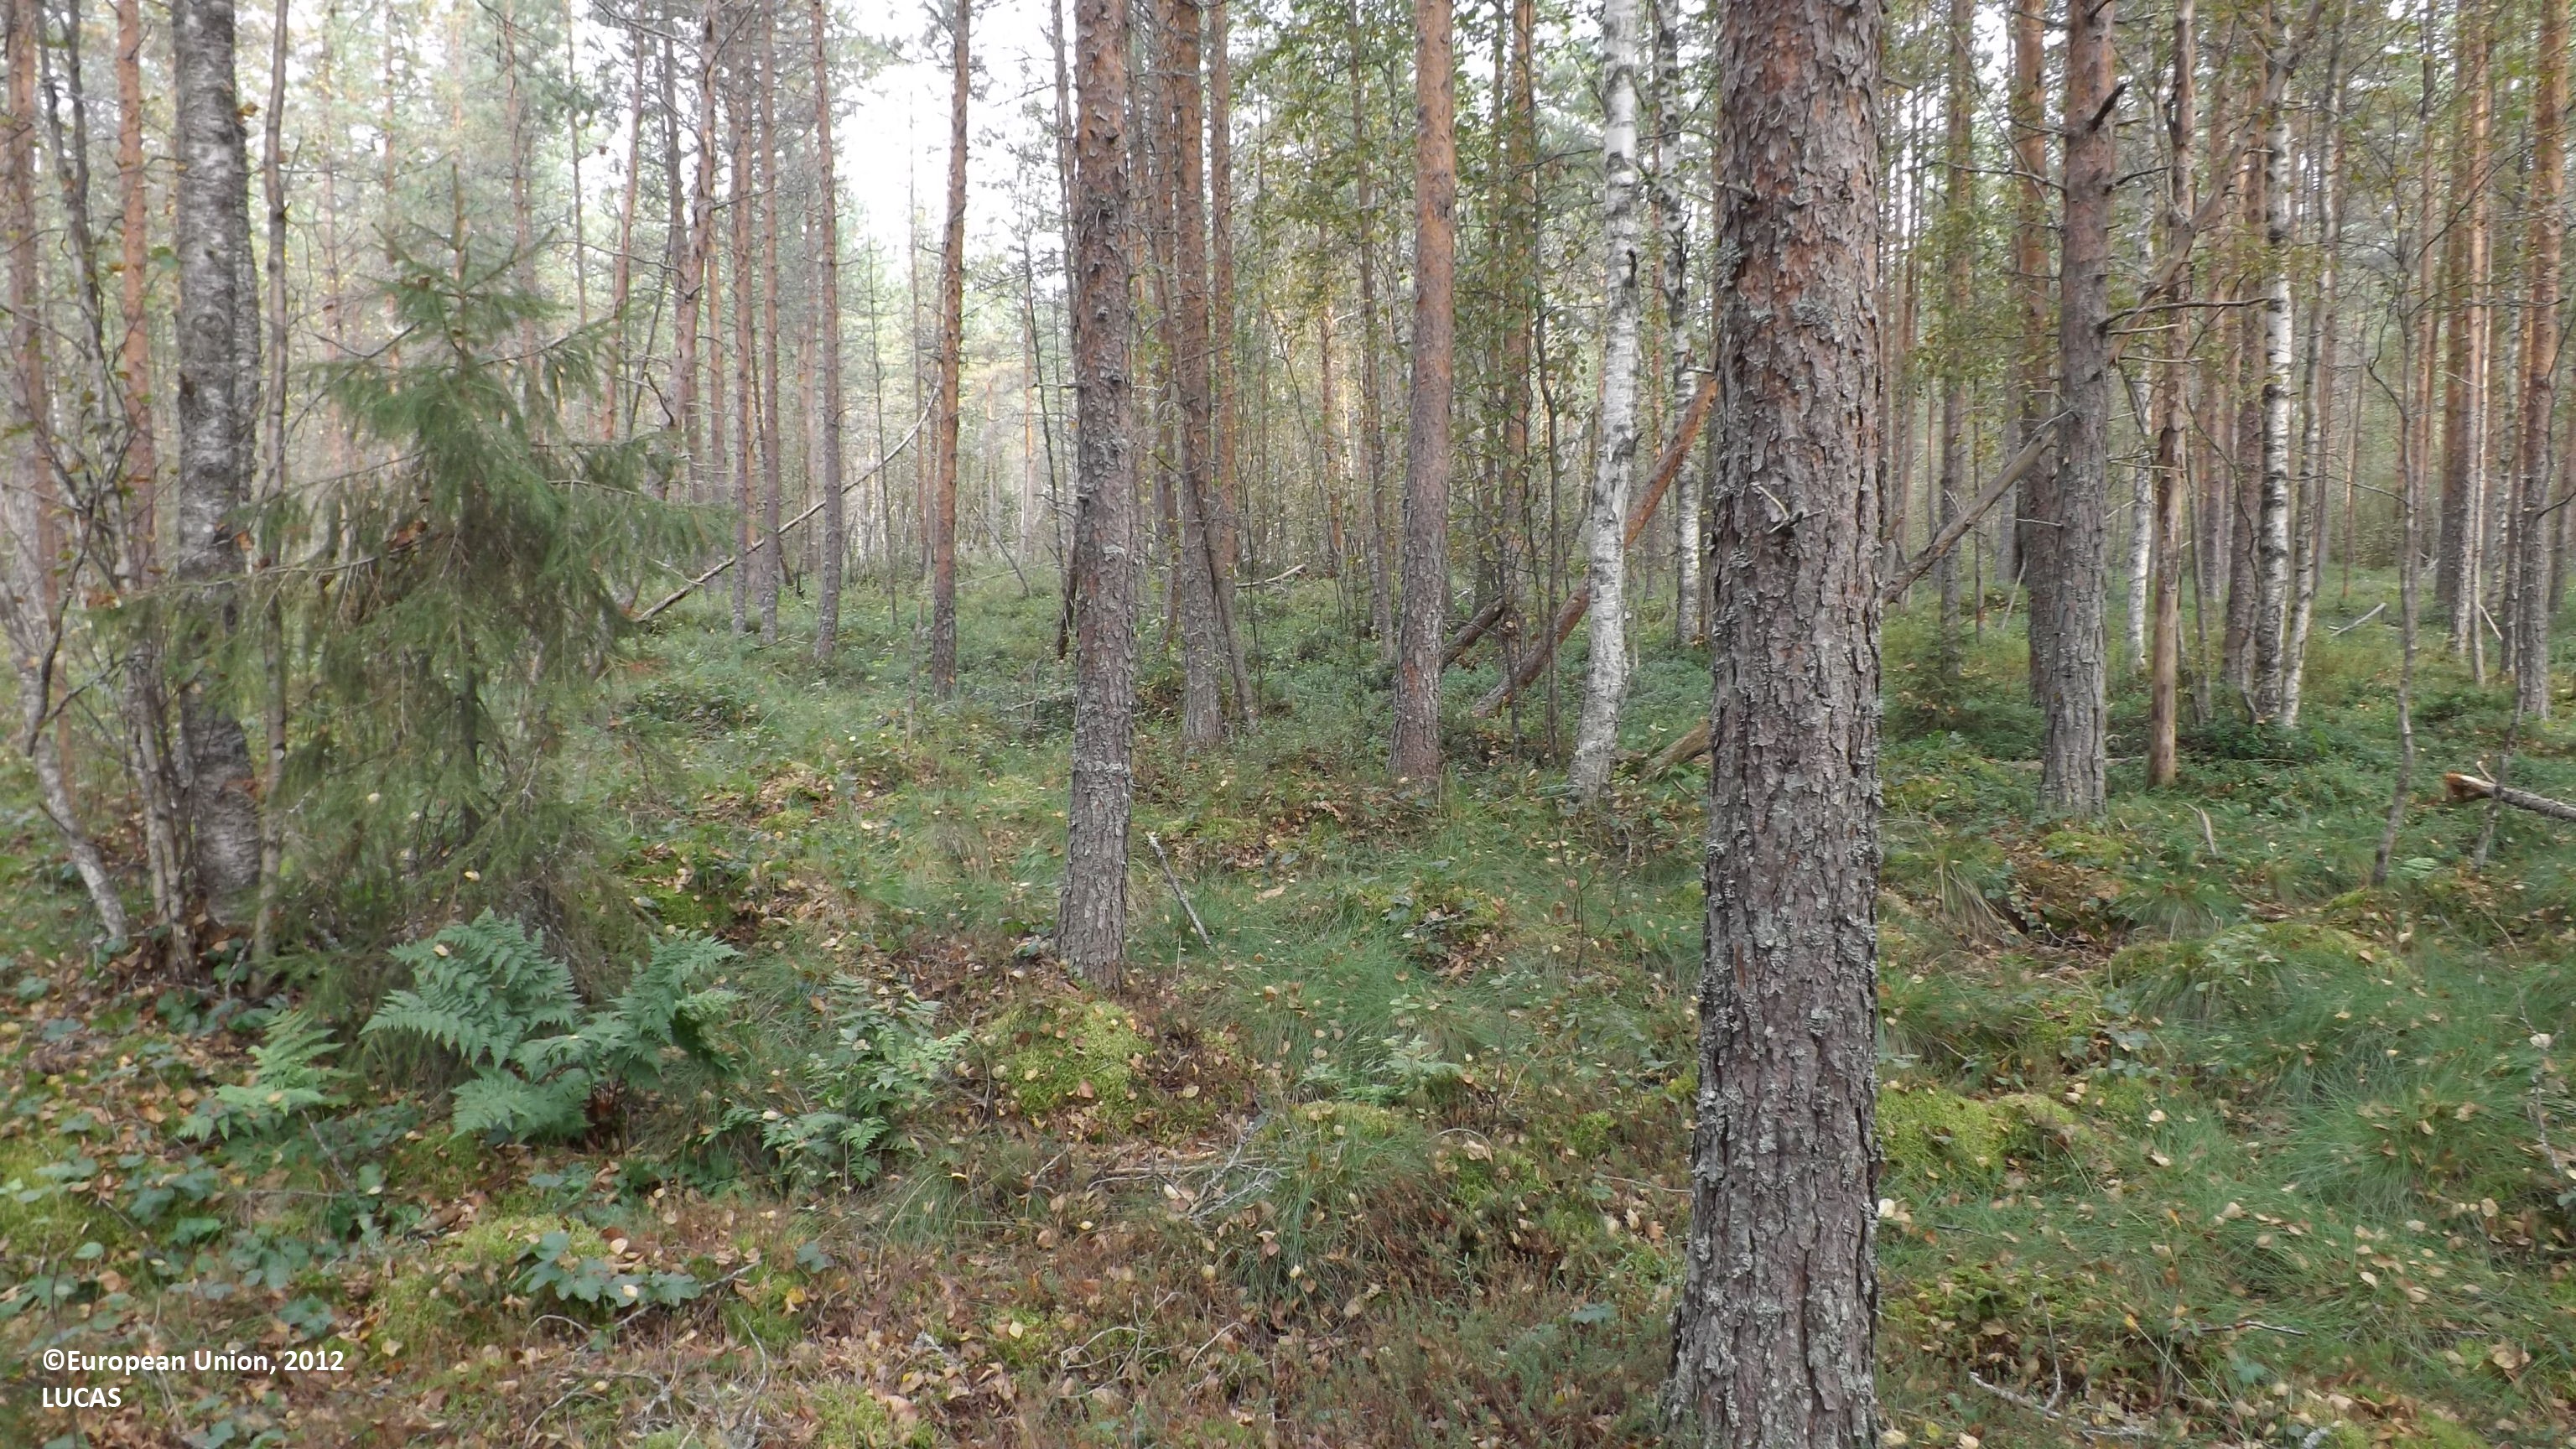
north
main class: Woodland
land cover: Pine dominated mixed woodland
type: boreal forest
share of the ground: 50 - 75 %
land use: Forestry
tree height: > 5 m
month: August
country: FI
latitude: 63.7419
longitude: 23.7385
